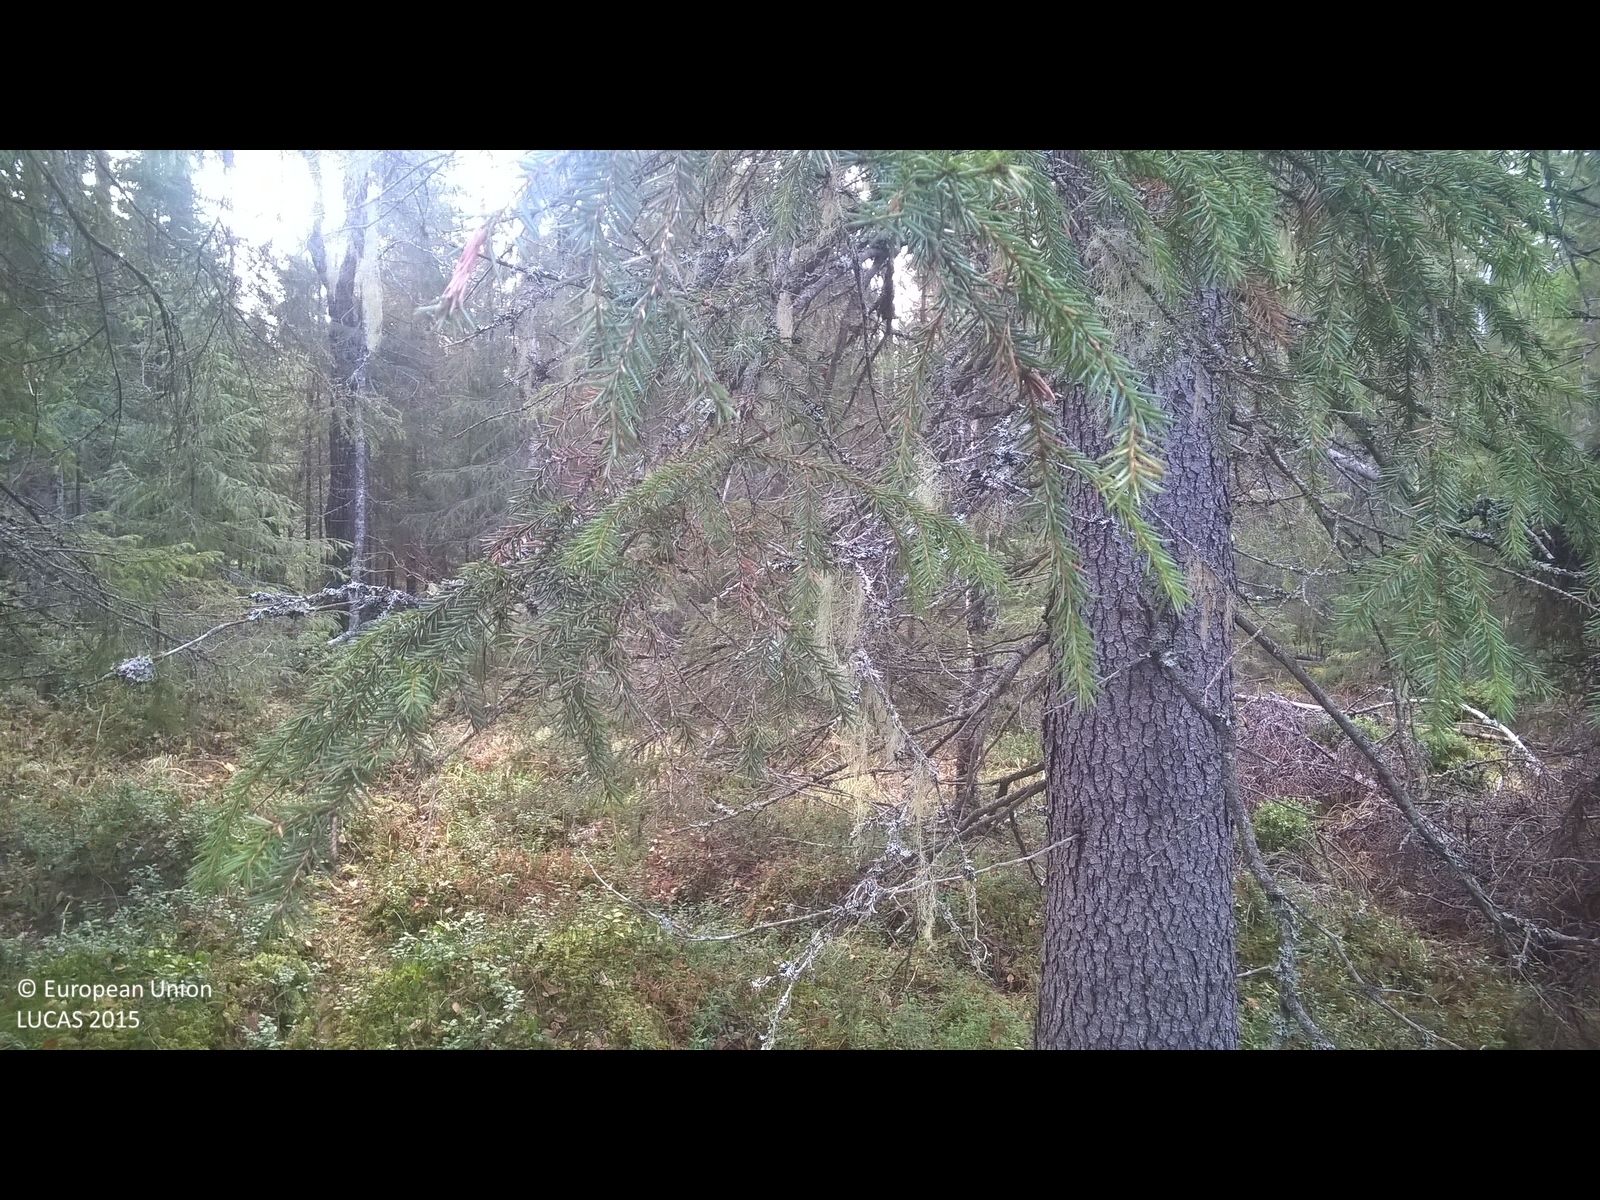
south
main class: Woodland
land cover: Spruce dominated coniferous woodland
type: boreal forest
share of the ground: 50 - 75 %
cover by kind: coniferous forest trees 60 %, lichens and mosses 30 %, broadleaved forest trees 10 %
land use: Forestry
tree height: > 5 m
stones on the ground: < 10 %
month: October
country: SE
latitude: 63.3388
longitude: 13.8759
